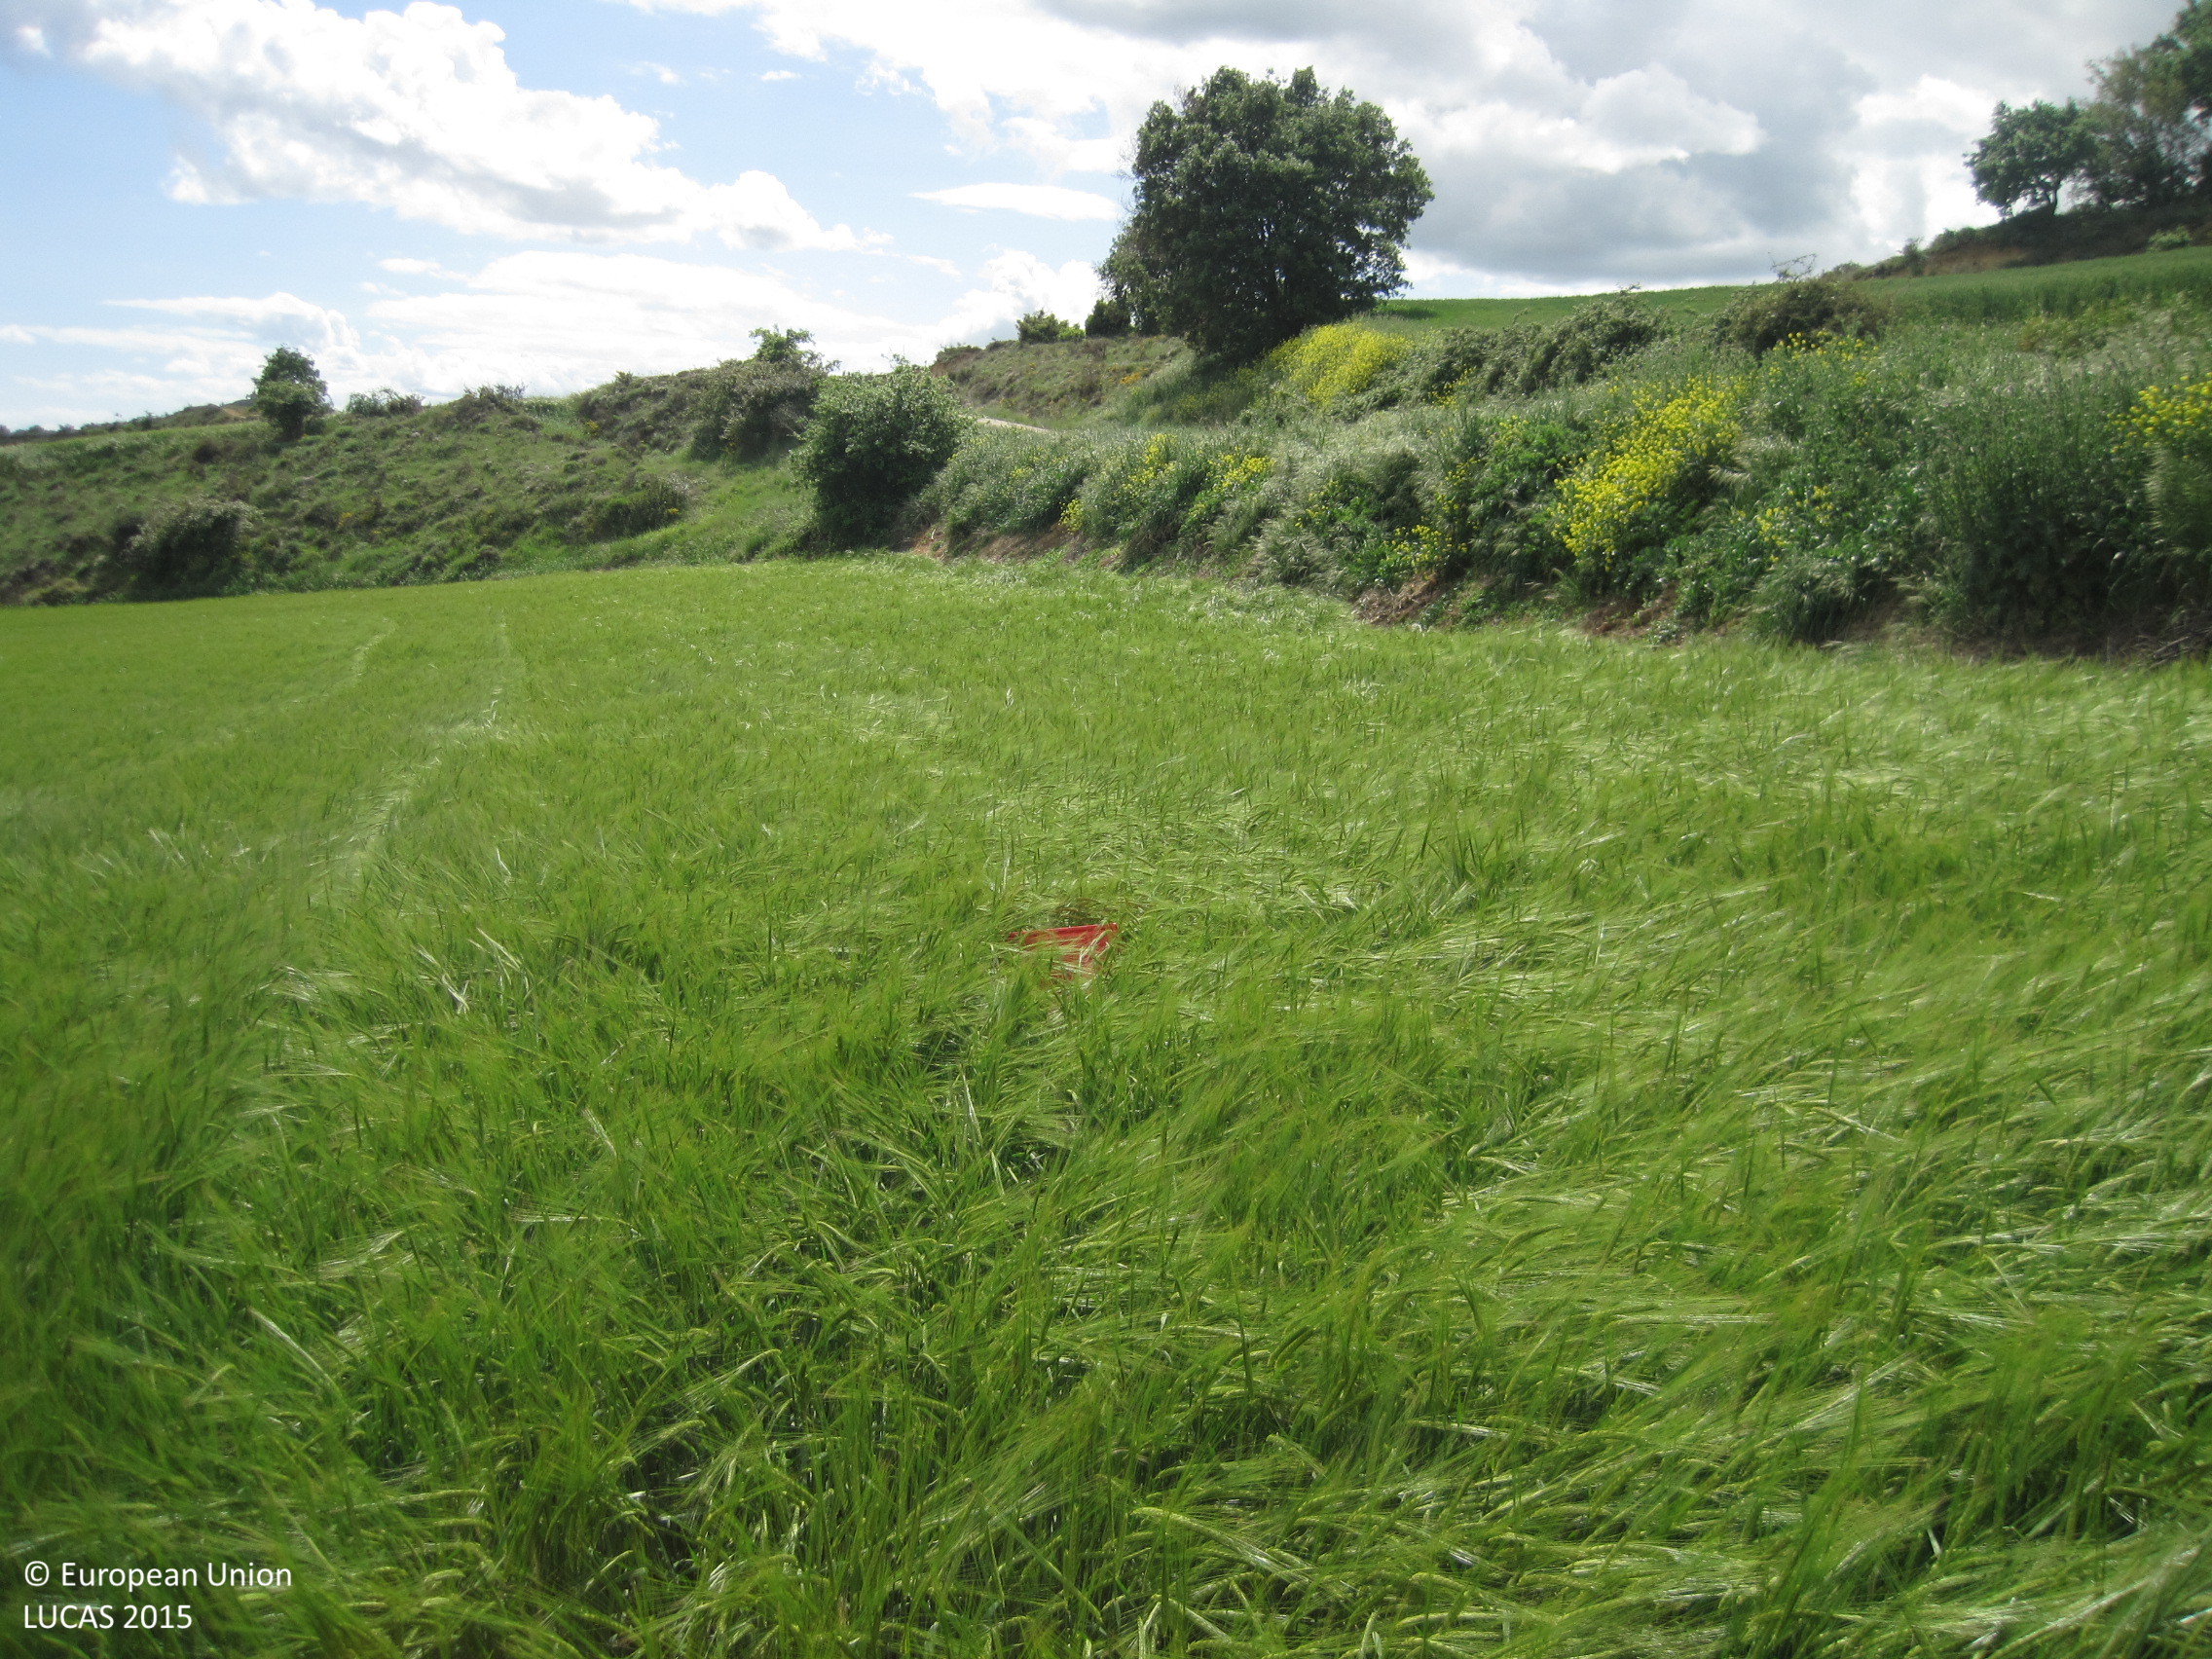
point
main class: Cropland
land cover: Barley
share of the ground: > 75 %
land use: Agriculture (excluding fallow land and kitchen gardens)
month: May
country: ES
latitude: 42.6851
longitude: -1.6938
